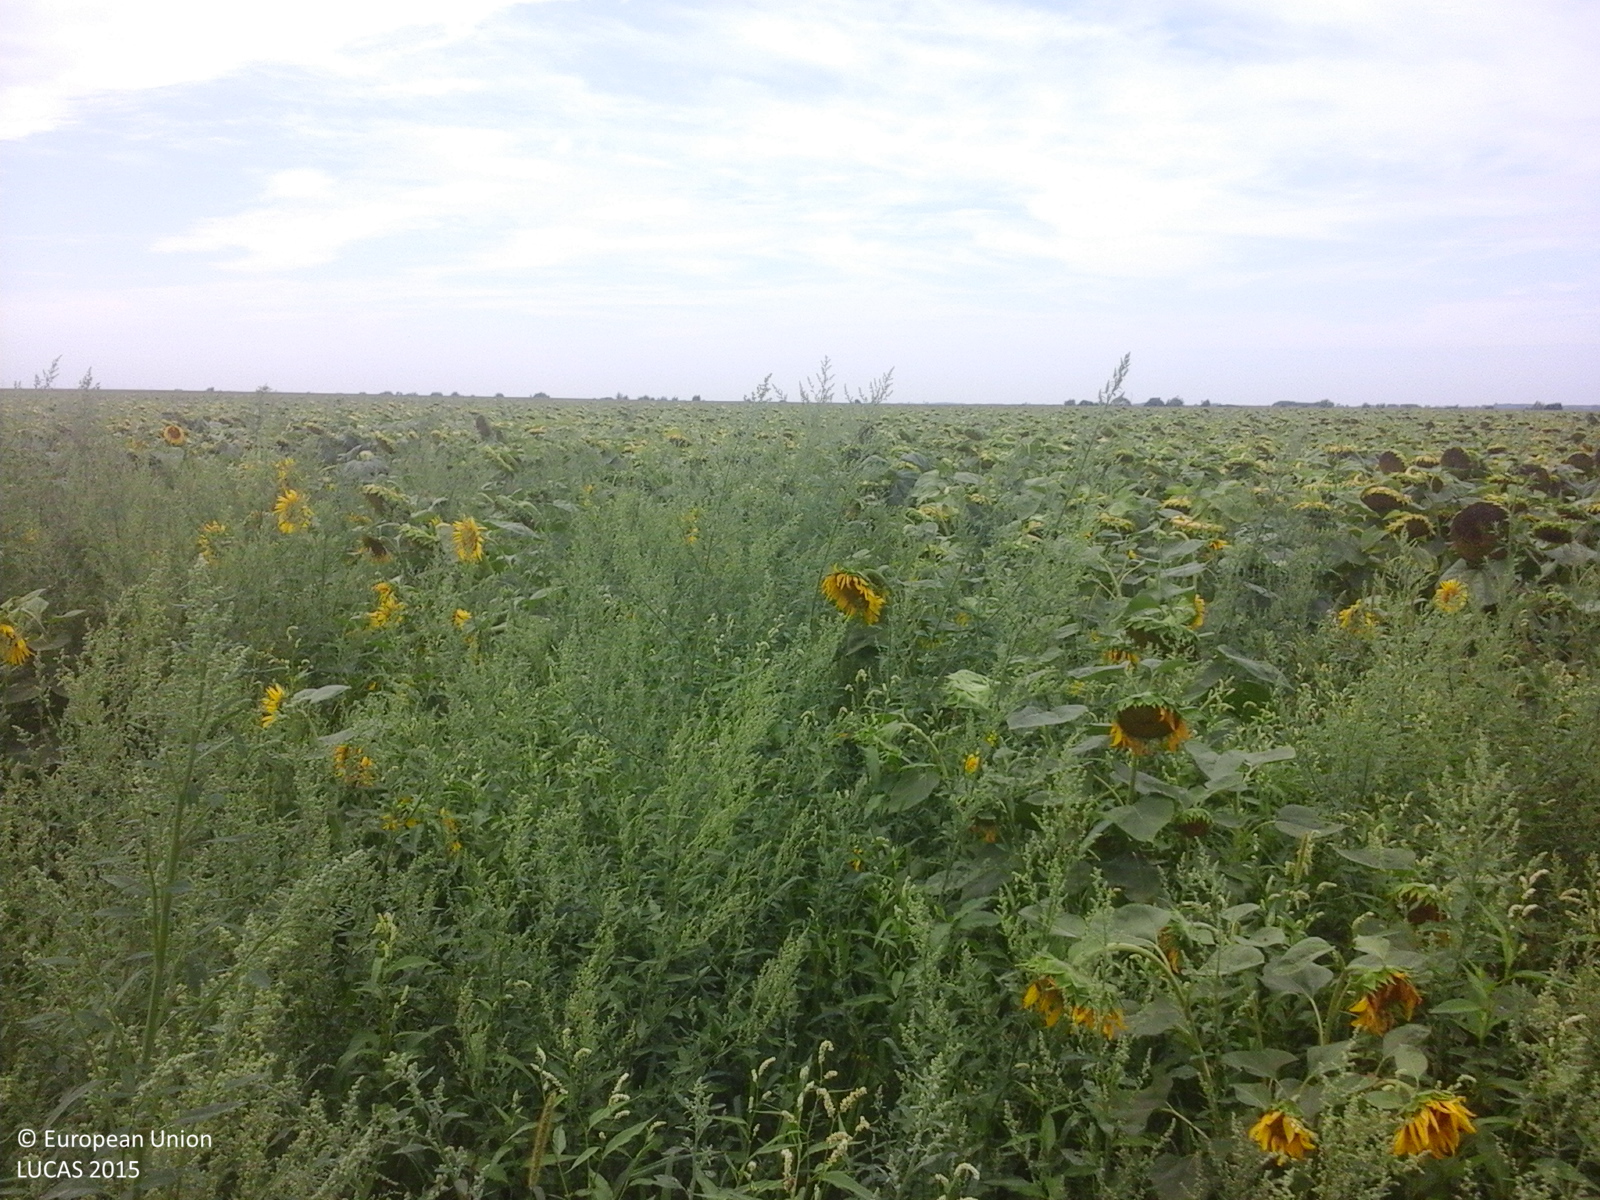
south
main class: Cropland
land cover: Sunflower
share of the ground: > 75 %
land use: Agriculture (excluding fallow land and kitchen gardens)
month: August
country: RO
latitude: 46.3869
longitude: 21.4667
